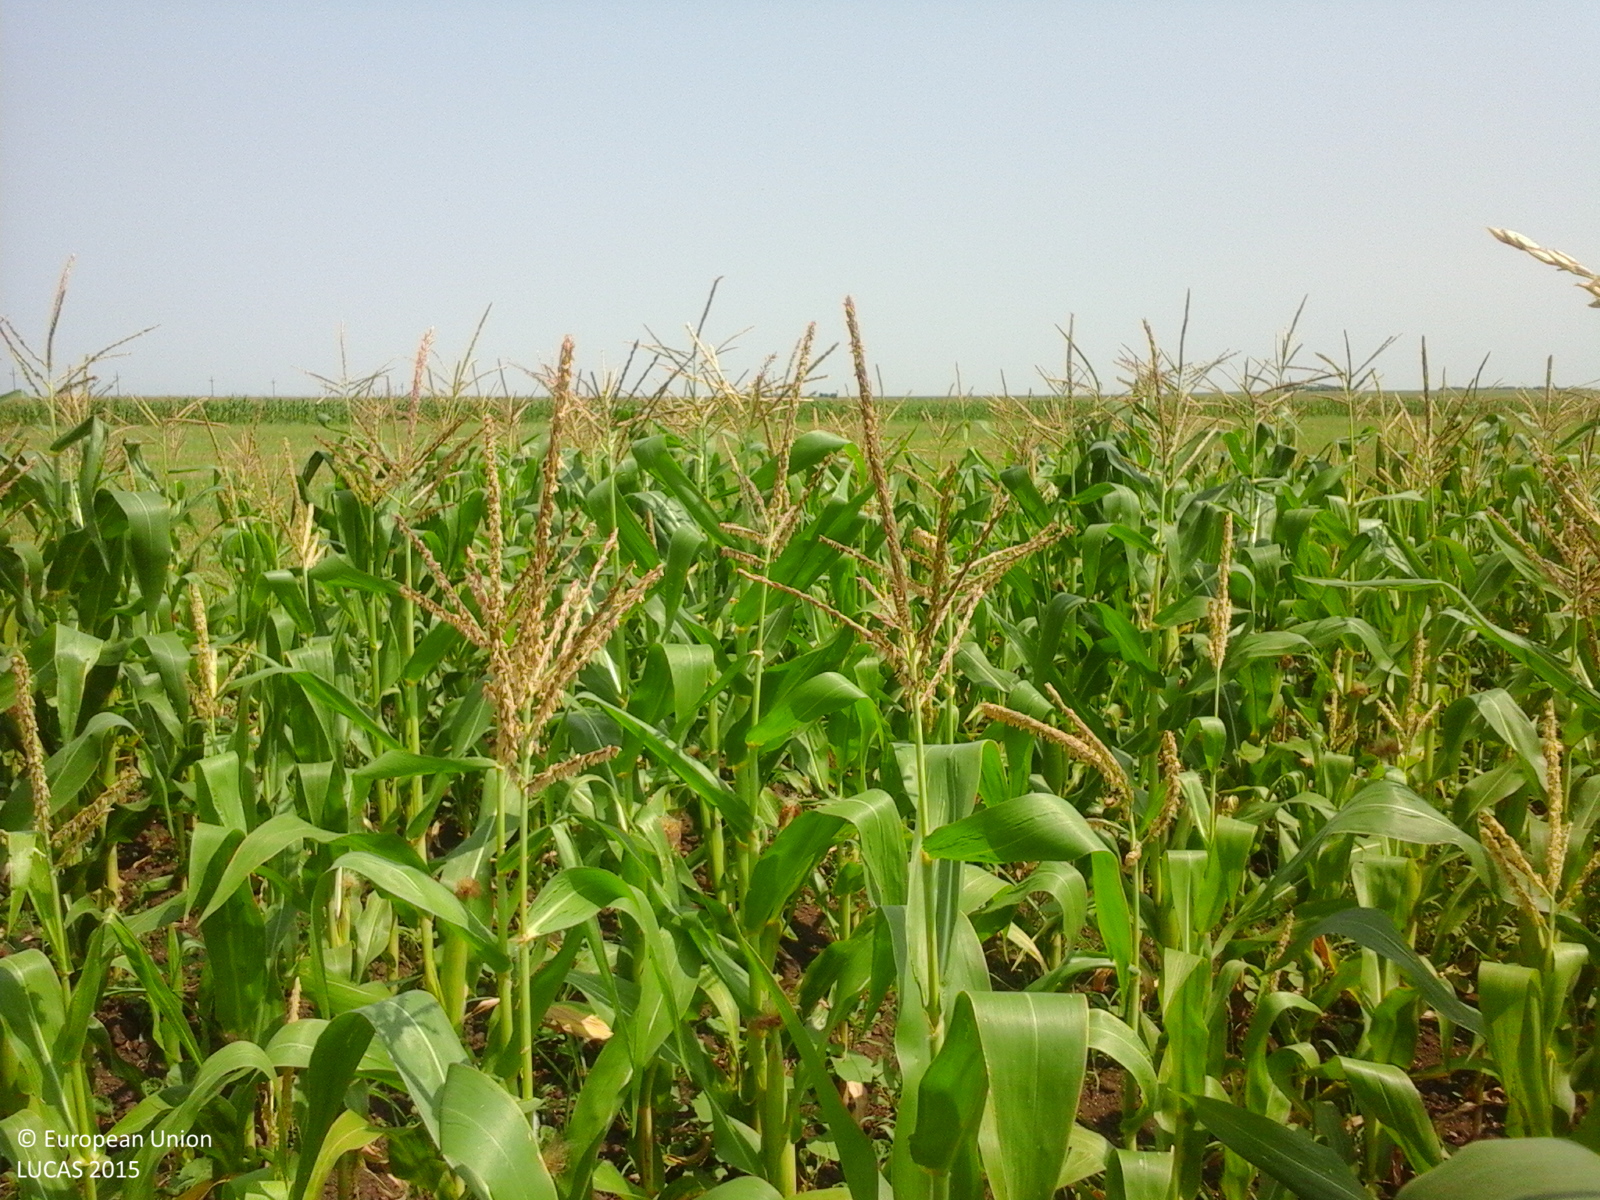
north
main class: Cropland
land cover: Maize
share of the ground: > 75 %
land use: Agriculture (excluding fallow land and kitchen gardens)
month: July
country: RO
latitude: 44.7908
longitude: 26.5649
